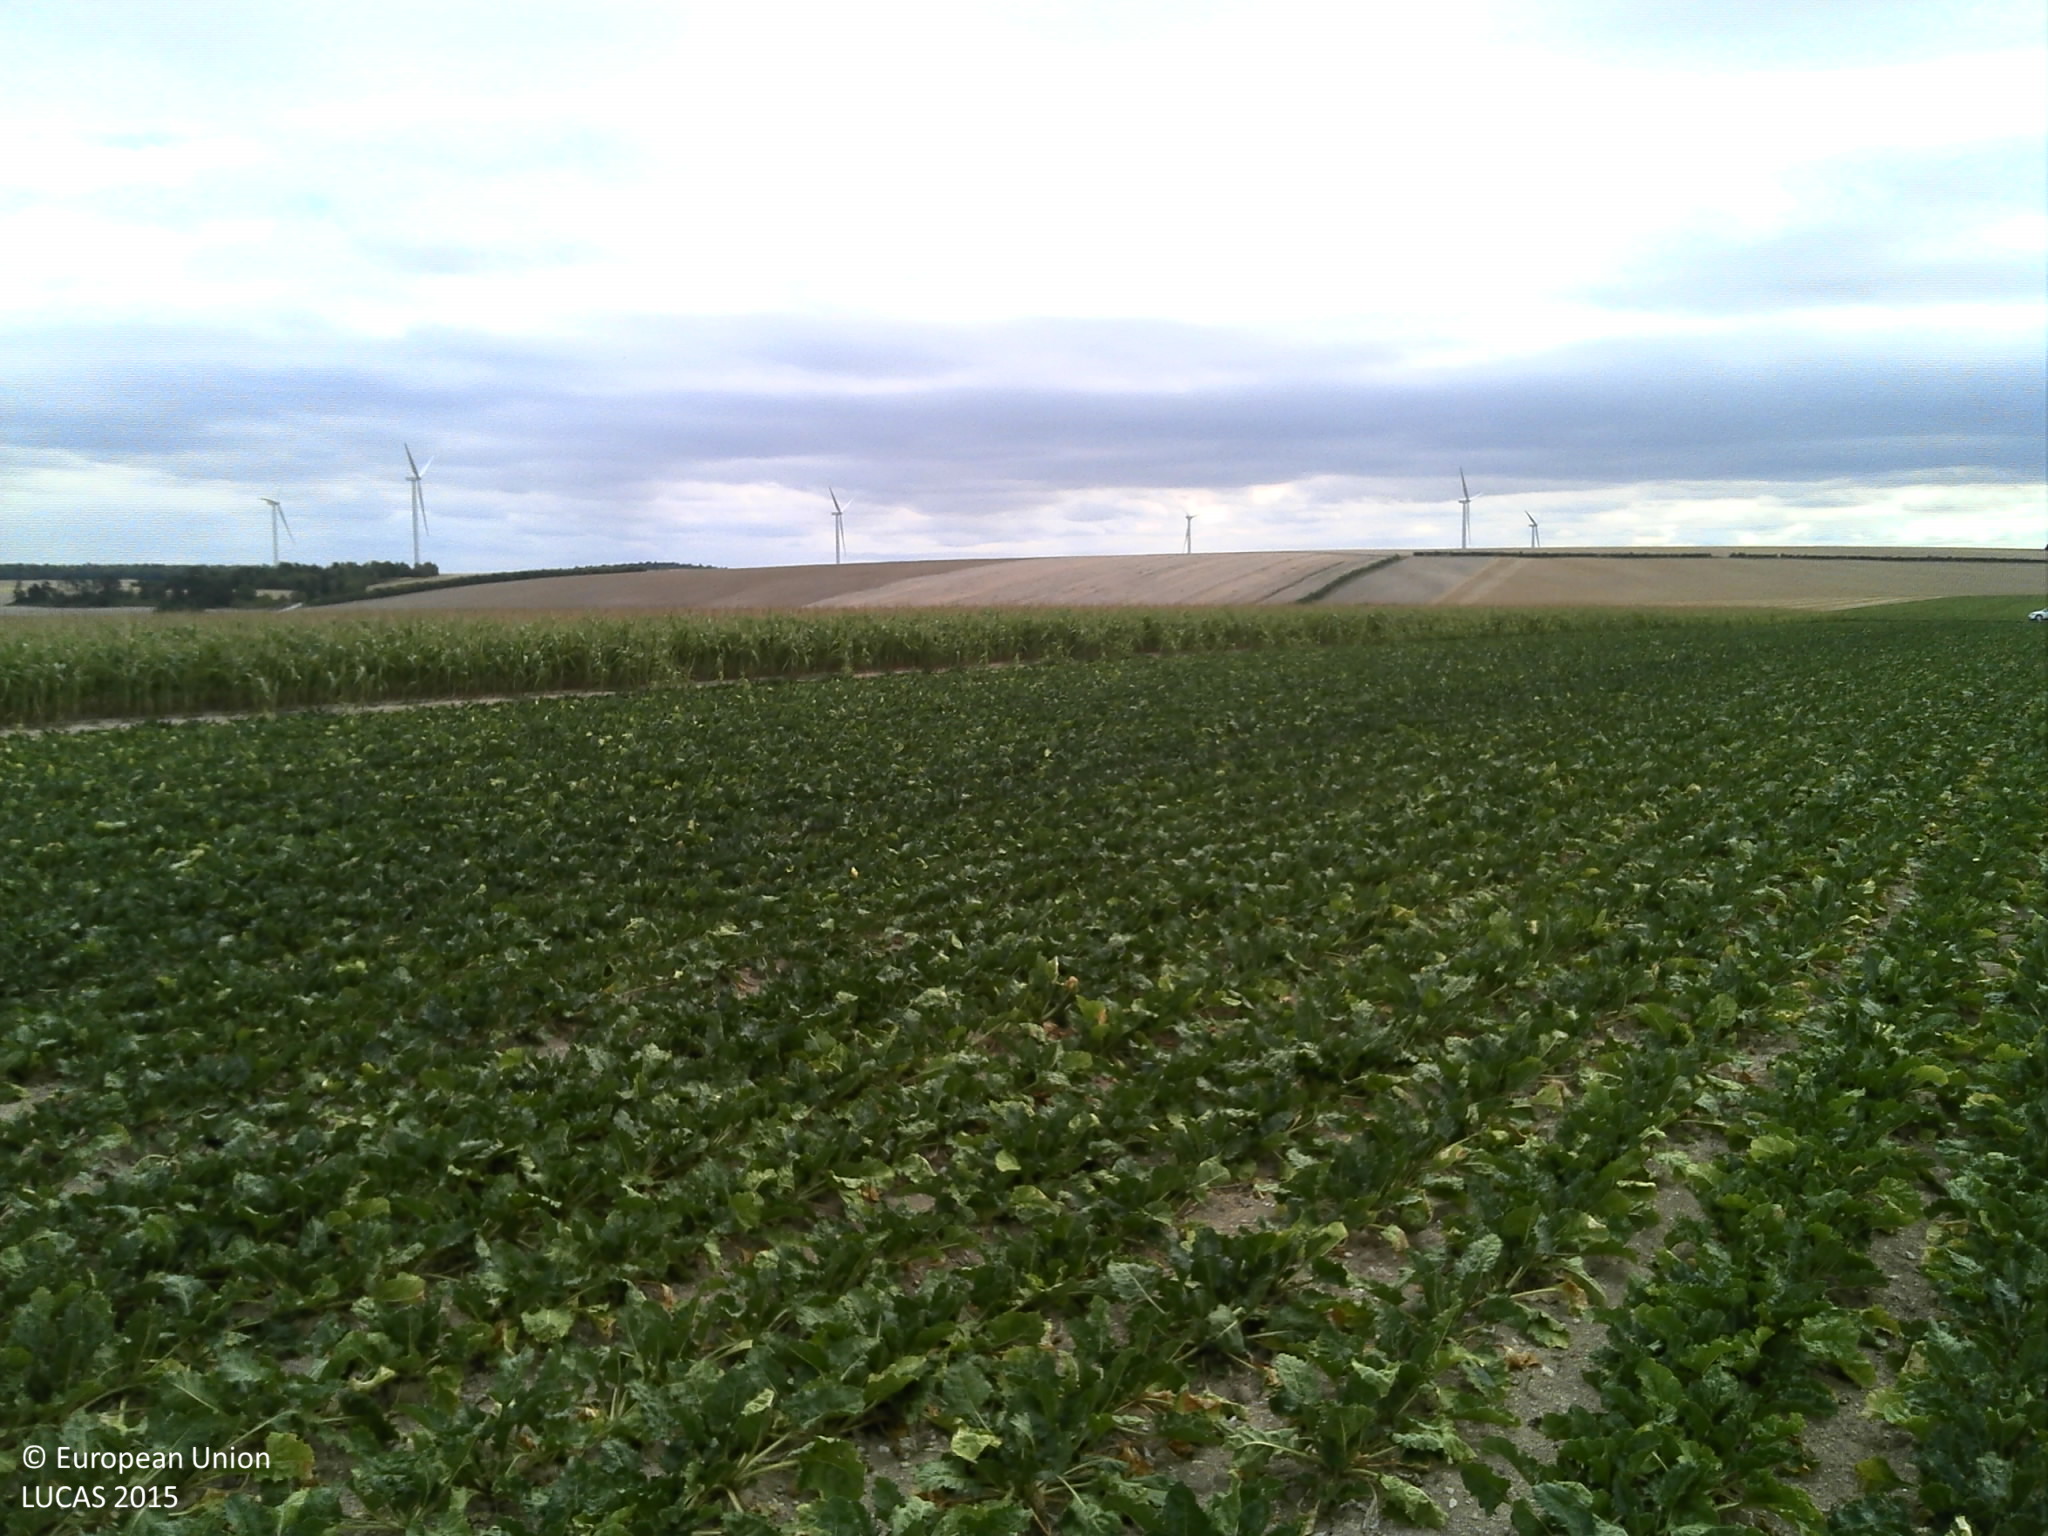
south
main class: Cropland
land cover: Sugar beet
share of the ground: 50 - 75 %
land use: Agriculture (excluding fallow land and kitchen gardens)
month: August
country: FR
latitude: 48.5047
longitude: 4.2170
